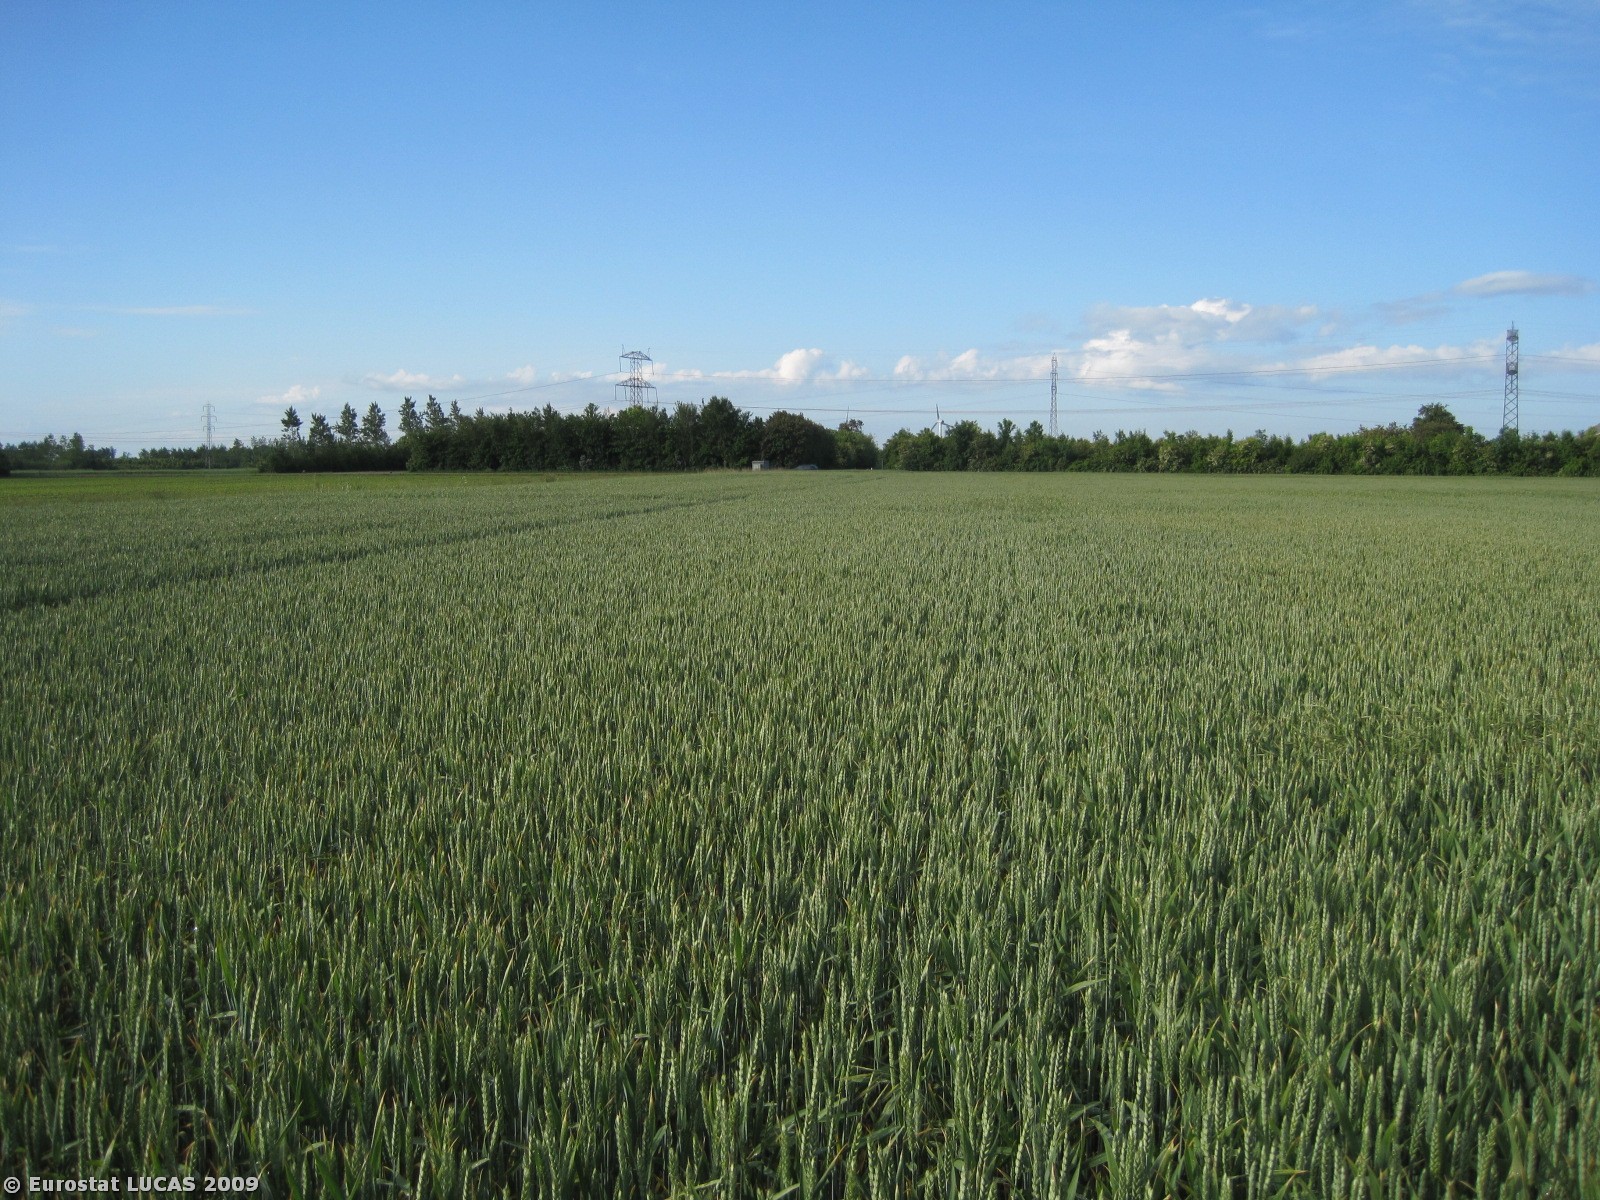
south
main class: Cropland
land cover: Common wheat
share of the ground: > 75 %
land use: Agriculture (excluding fallow land and kitchen gardens)
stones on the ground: < 10 %
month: June
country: DK
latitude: 57.0686
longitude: 10.0823
